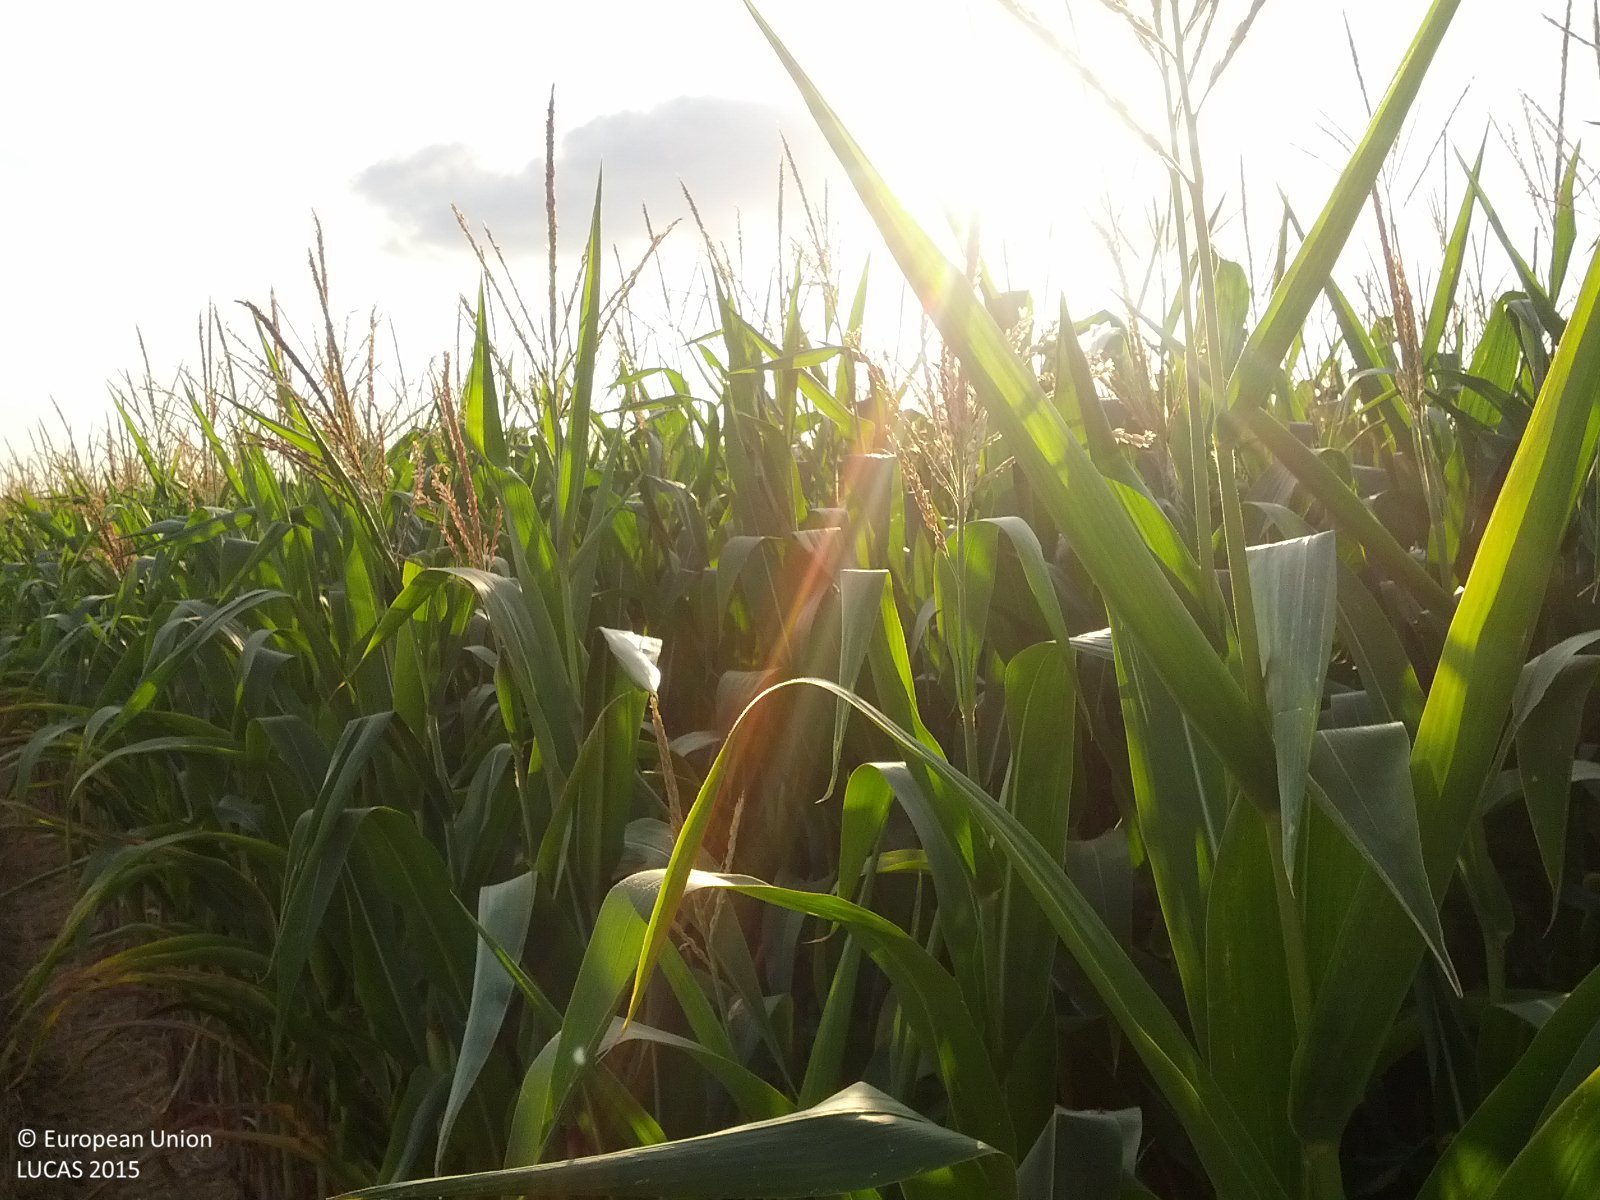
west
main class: Cropland
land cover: Maize
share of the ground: > 75 %
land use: Agriculture (excluding fallow land and kitchen gardens)
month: July
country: AT
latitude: 48.6410
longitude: 16.2618
